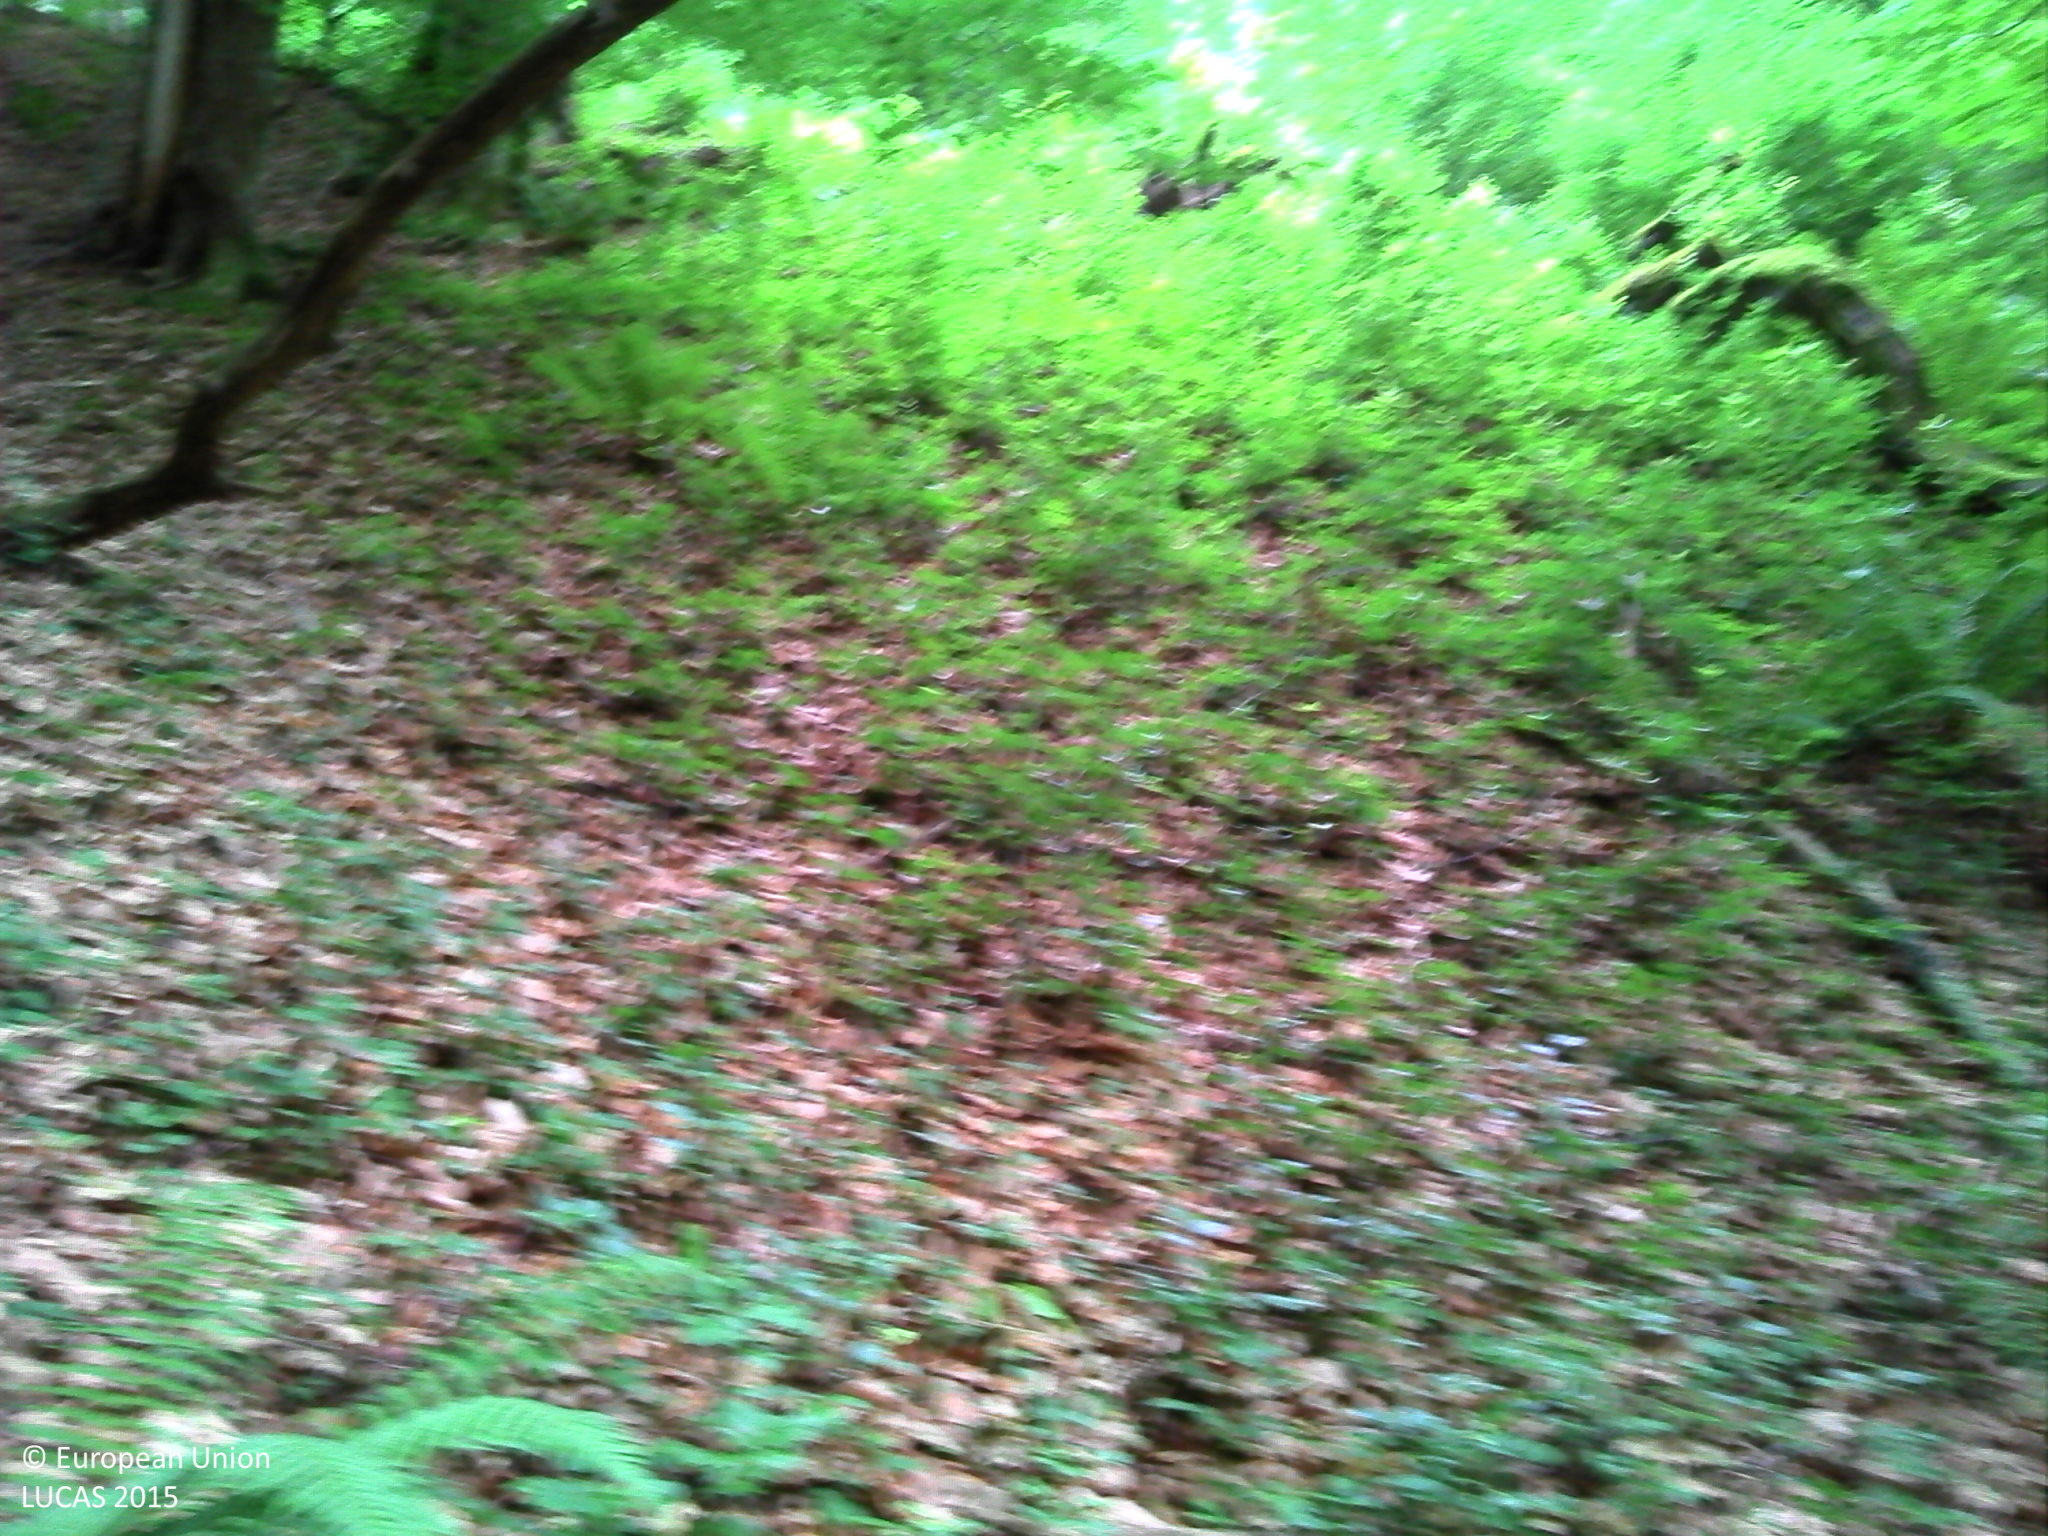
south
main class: Woodland
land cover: Broadleaved woodland
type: acidophilous oak and oak-birch forest
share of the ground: > 75 %
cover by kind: broadleaved forest trees 55 %, shrubs 20 %, herbaceous plants 10 %, lichens and mosses 10 %, coniferous forest trees 5 %
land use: Forestry
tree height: > 5 m
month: July
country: FR
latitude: 42.9808
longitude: 0.8183
